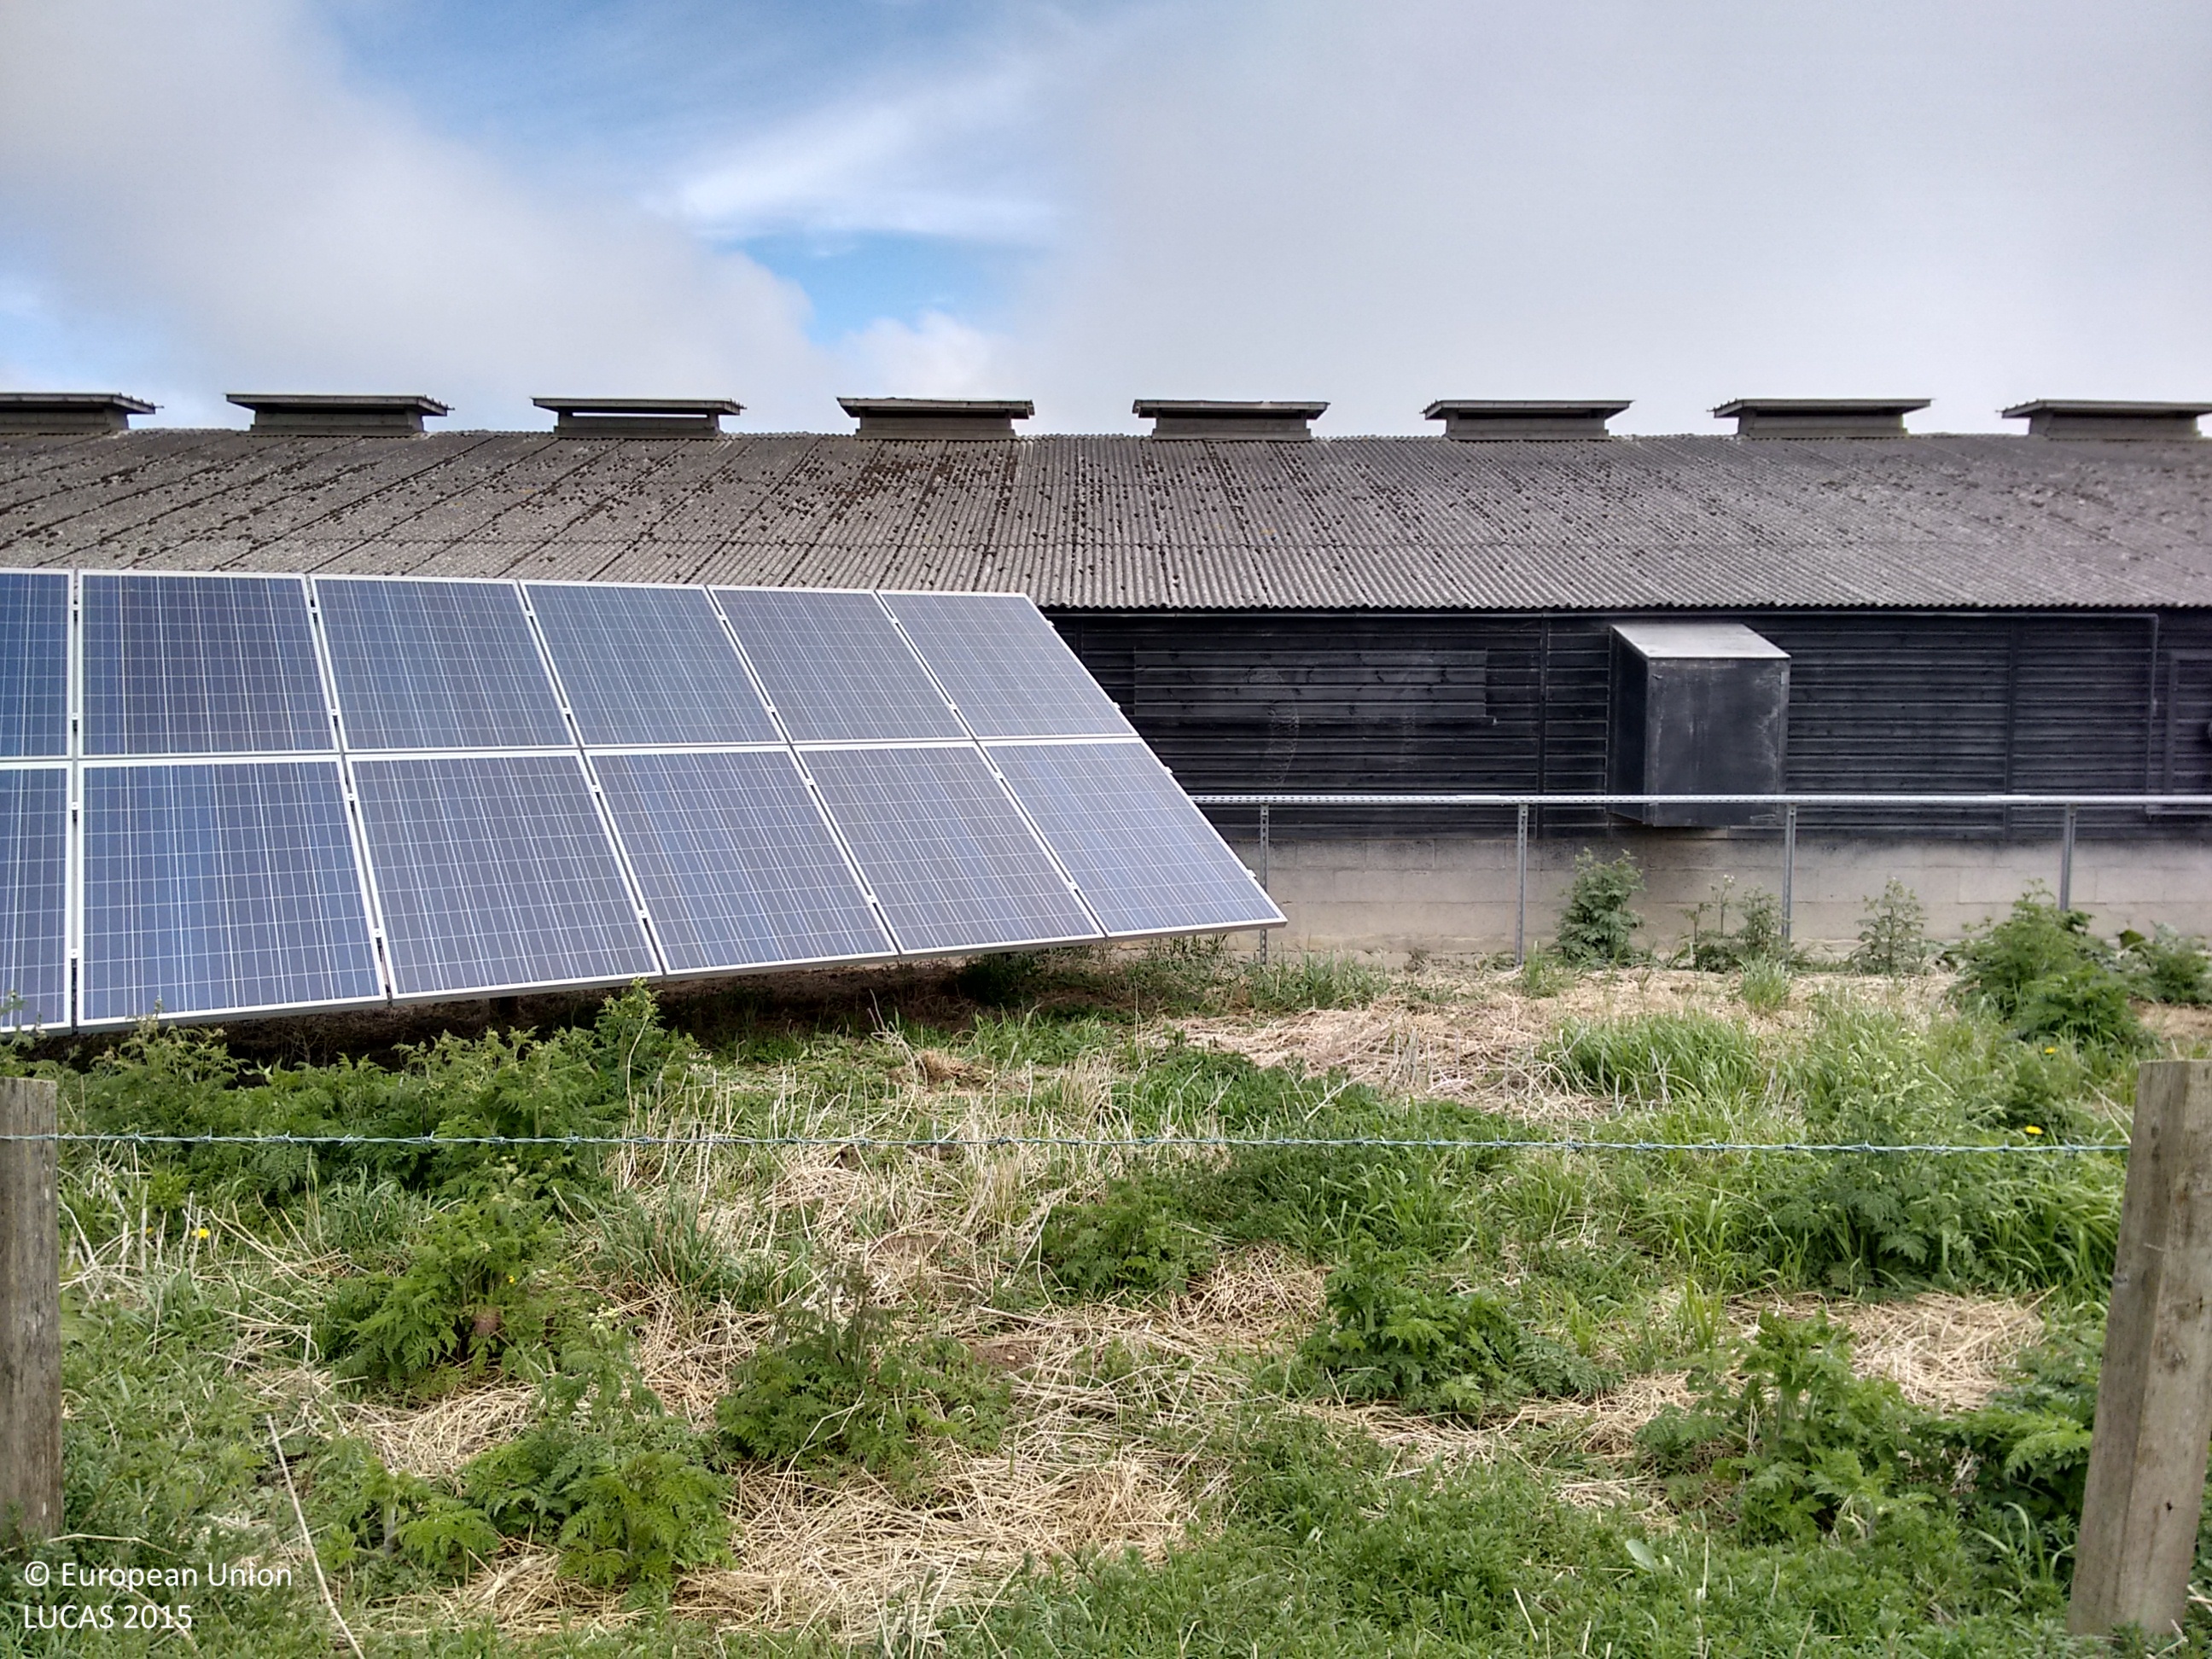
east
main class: Grassland
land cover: Grassland without tree/shrub cover
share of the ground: > 75 %
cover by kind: herbaceous plants 100 %
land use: Agriculture (excluding fallow land and kitchen gardens)
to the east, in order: Grassland without tree/shrub cover; Artificial constructions in urban areas; Grassland without tree/shrub cover; Managed hedges; Grassland without tree/shrub cover; Managed hedges; Ditches and canals; Grass margins; Tracks; Grass margins; Managed hedges; Grassland without tree/shrub cover
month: May
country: GB
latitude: 53.9569
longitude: -0.3215
